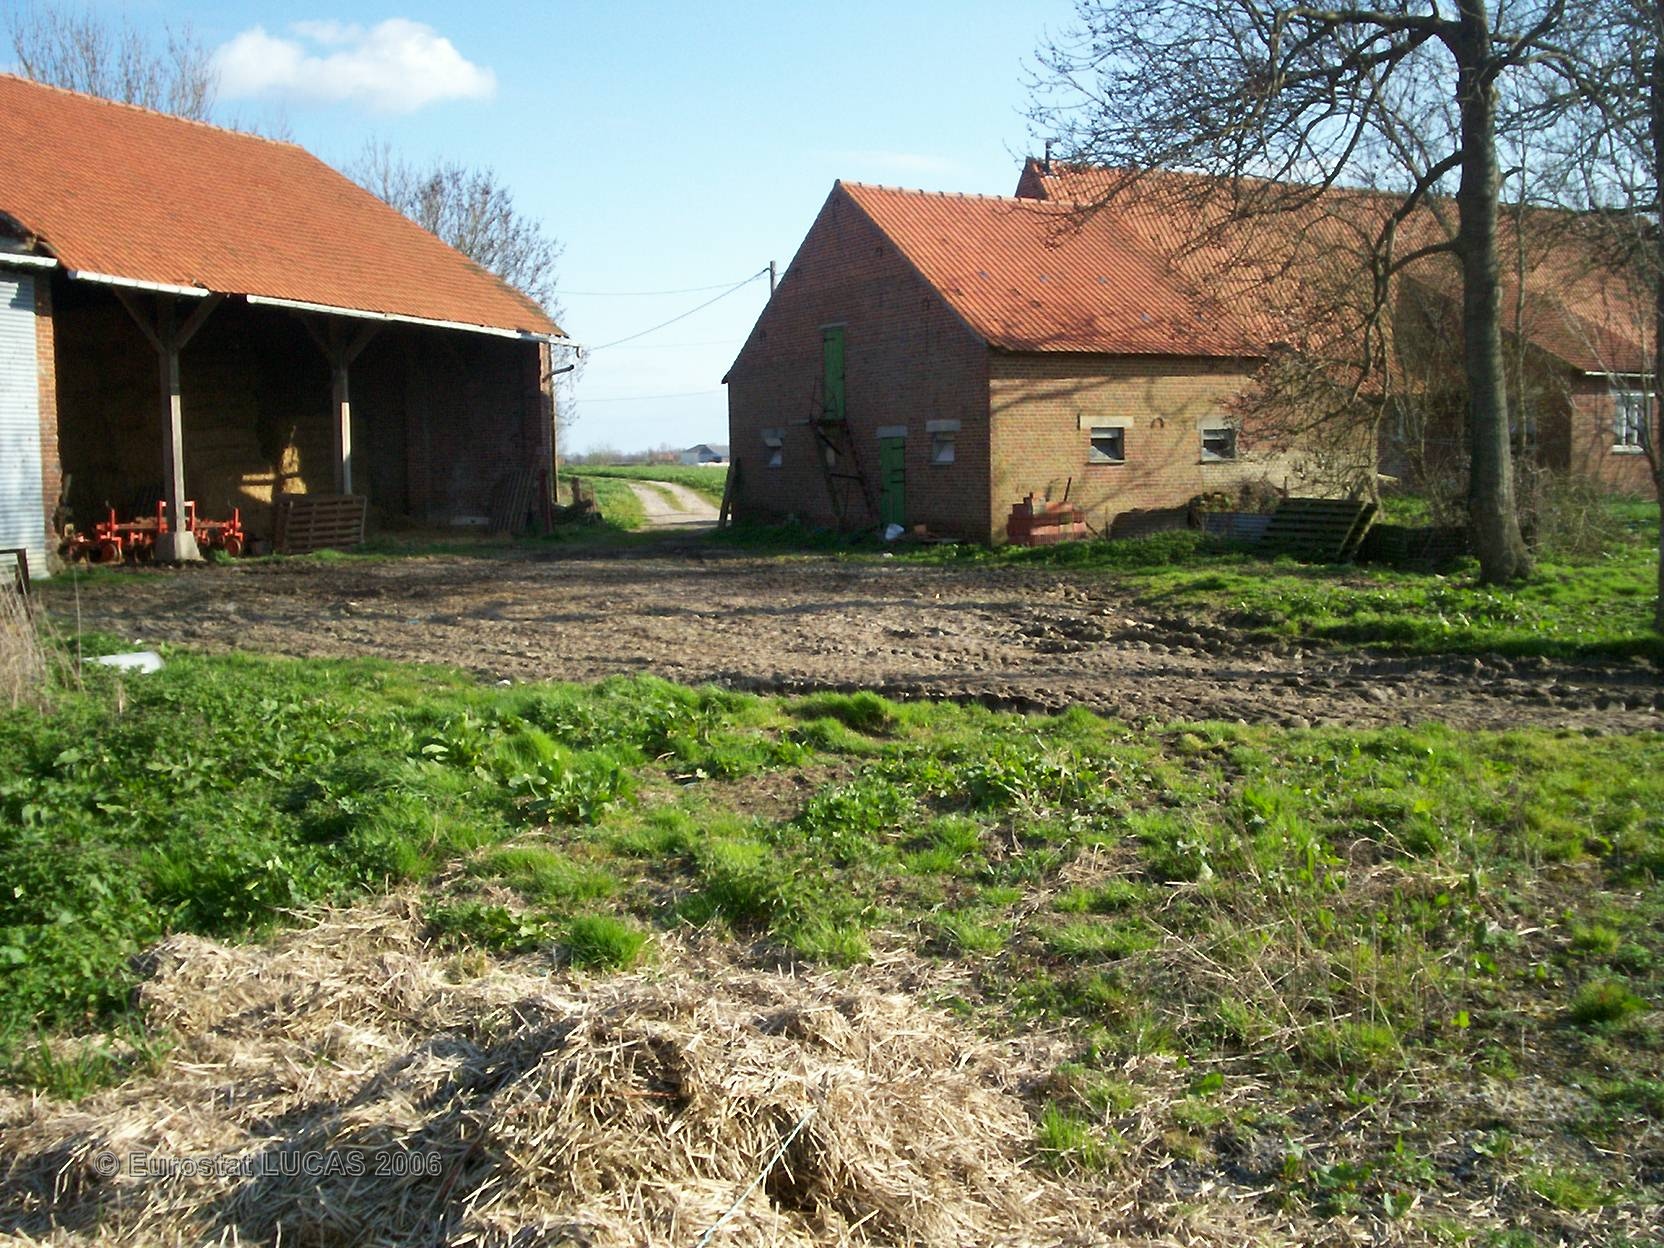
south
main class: Grassland
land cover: Grassland with sparse tree/shrub cover
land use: Agriculture (excluding fallow land and kitchen gardens)
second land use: Residential
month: April
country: FR
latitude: 50.8760
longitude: 2.4976
